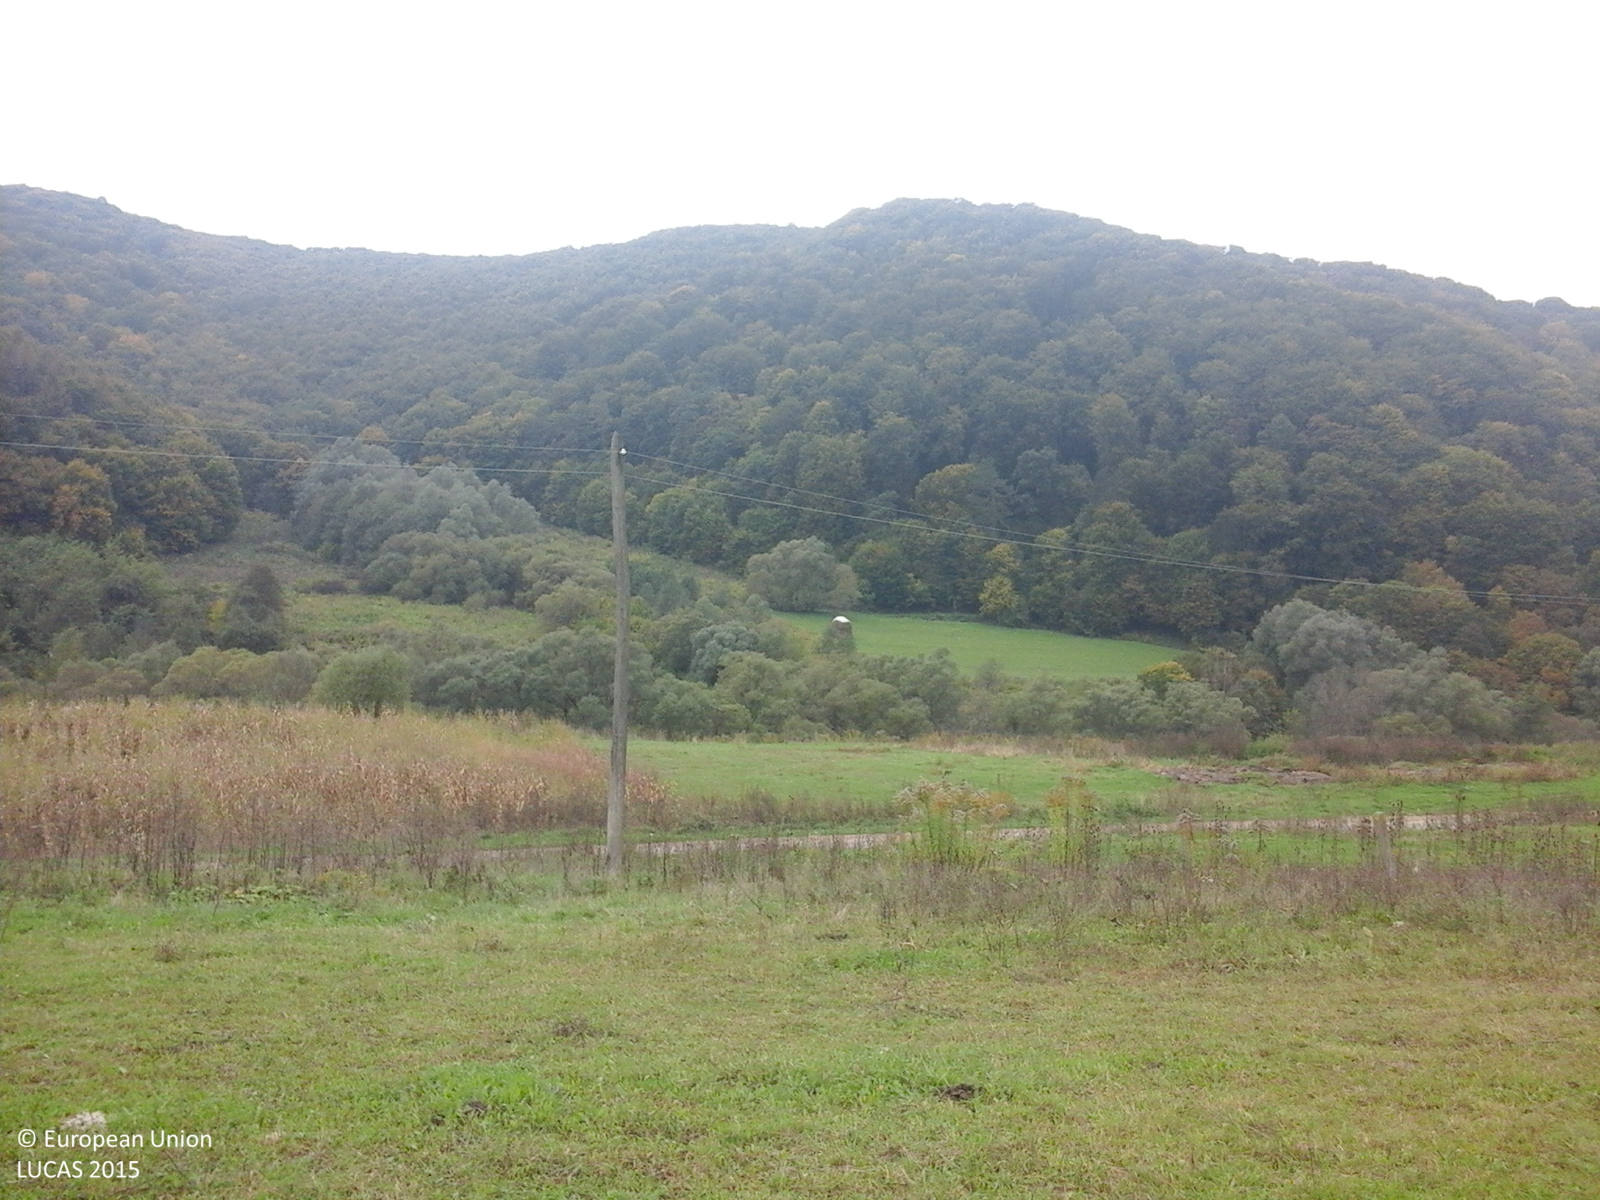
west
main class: Grassland
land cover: Grassland without tree/shrub cover
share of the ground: > 75 %
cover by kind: herbaceous plants 100 %
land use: Agriculture (excluding fallow land and kitchen gardens)
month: October
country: RO
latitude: 46.1616
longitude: 24.7624
